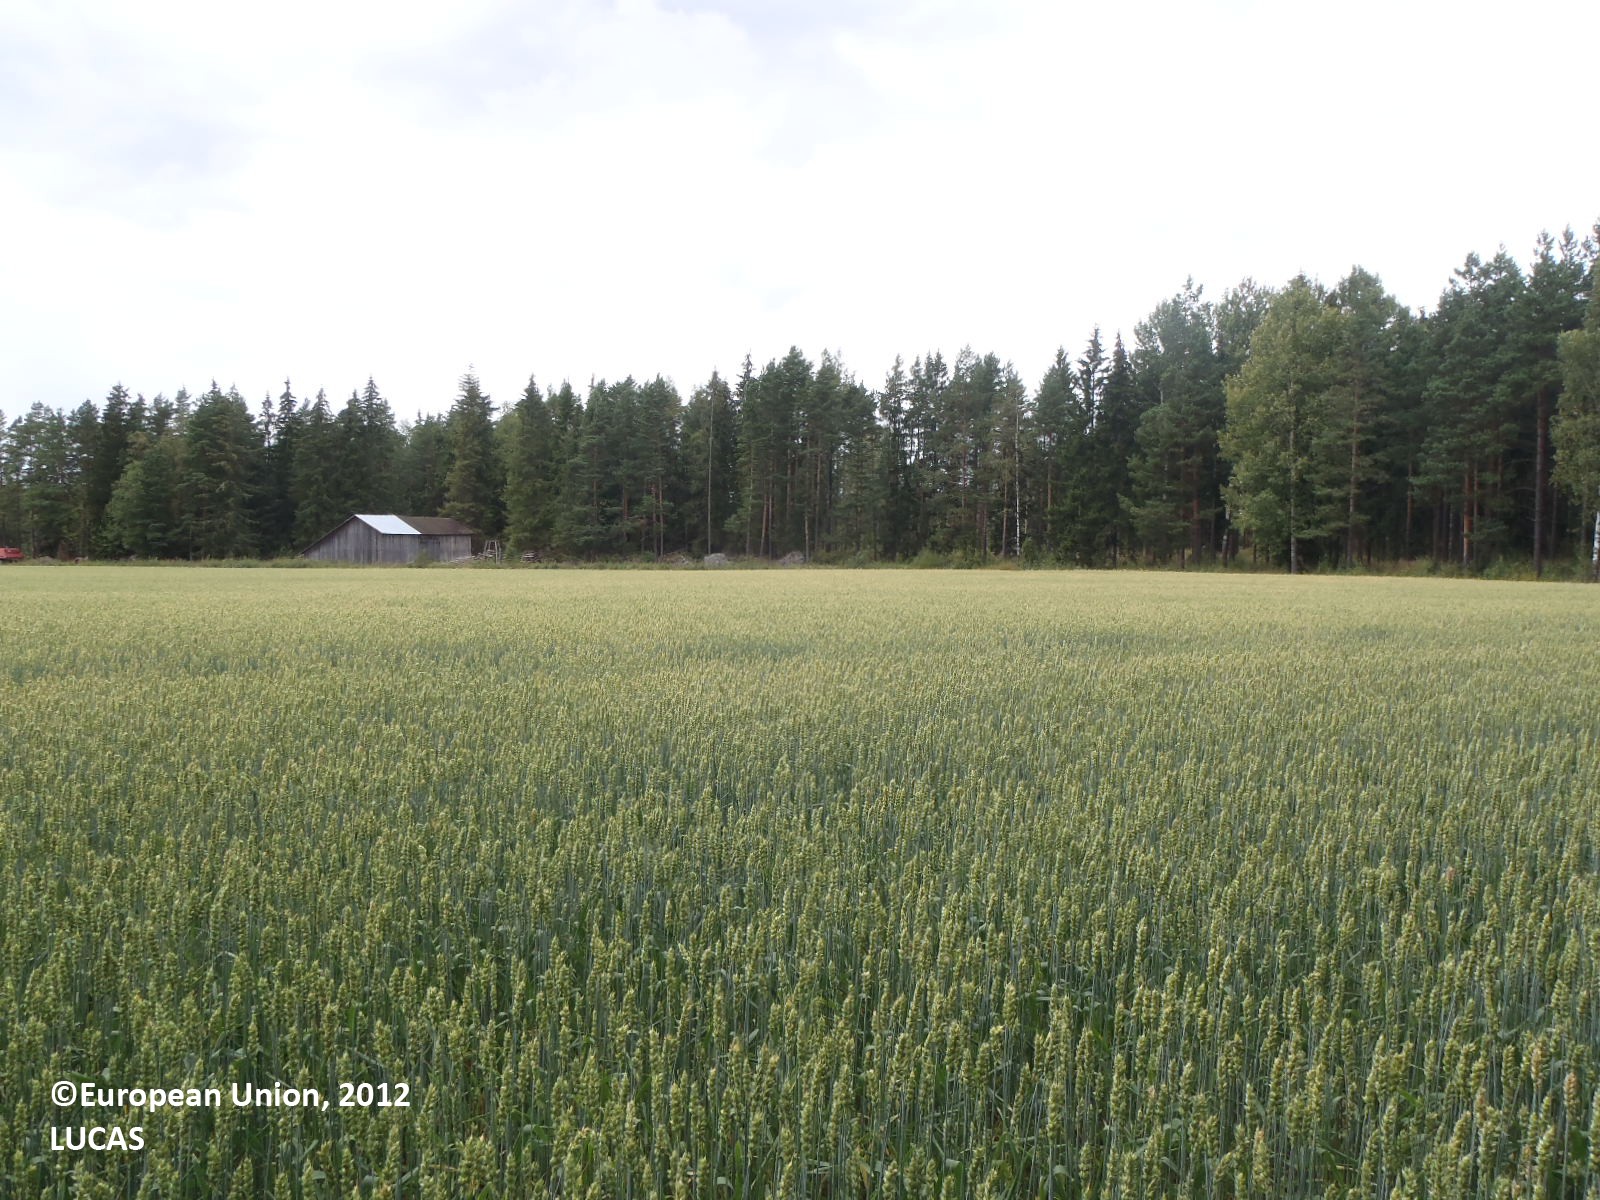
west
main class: Cropland
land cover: Barley
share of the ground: > 75 %
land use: Agriculture (excluding fallow land and kitchen gardens)
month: August
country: FI
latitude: 60.5617
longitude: 22.1951
